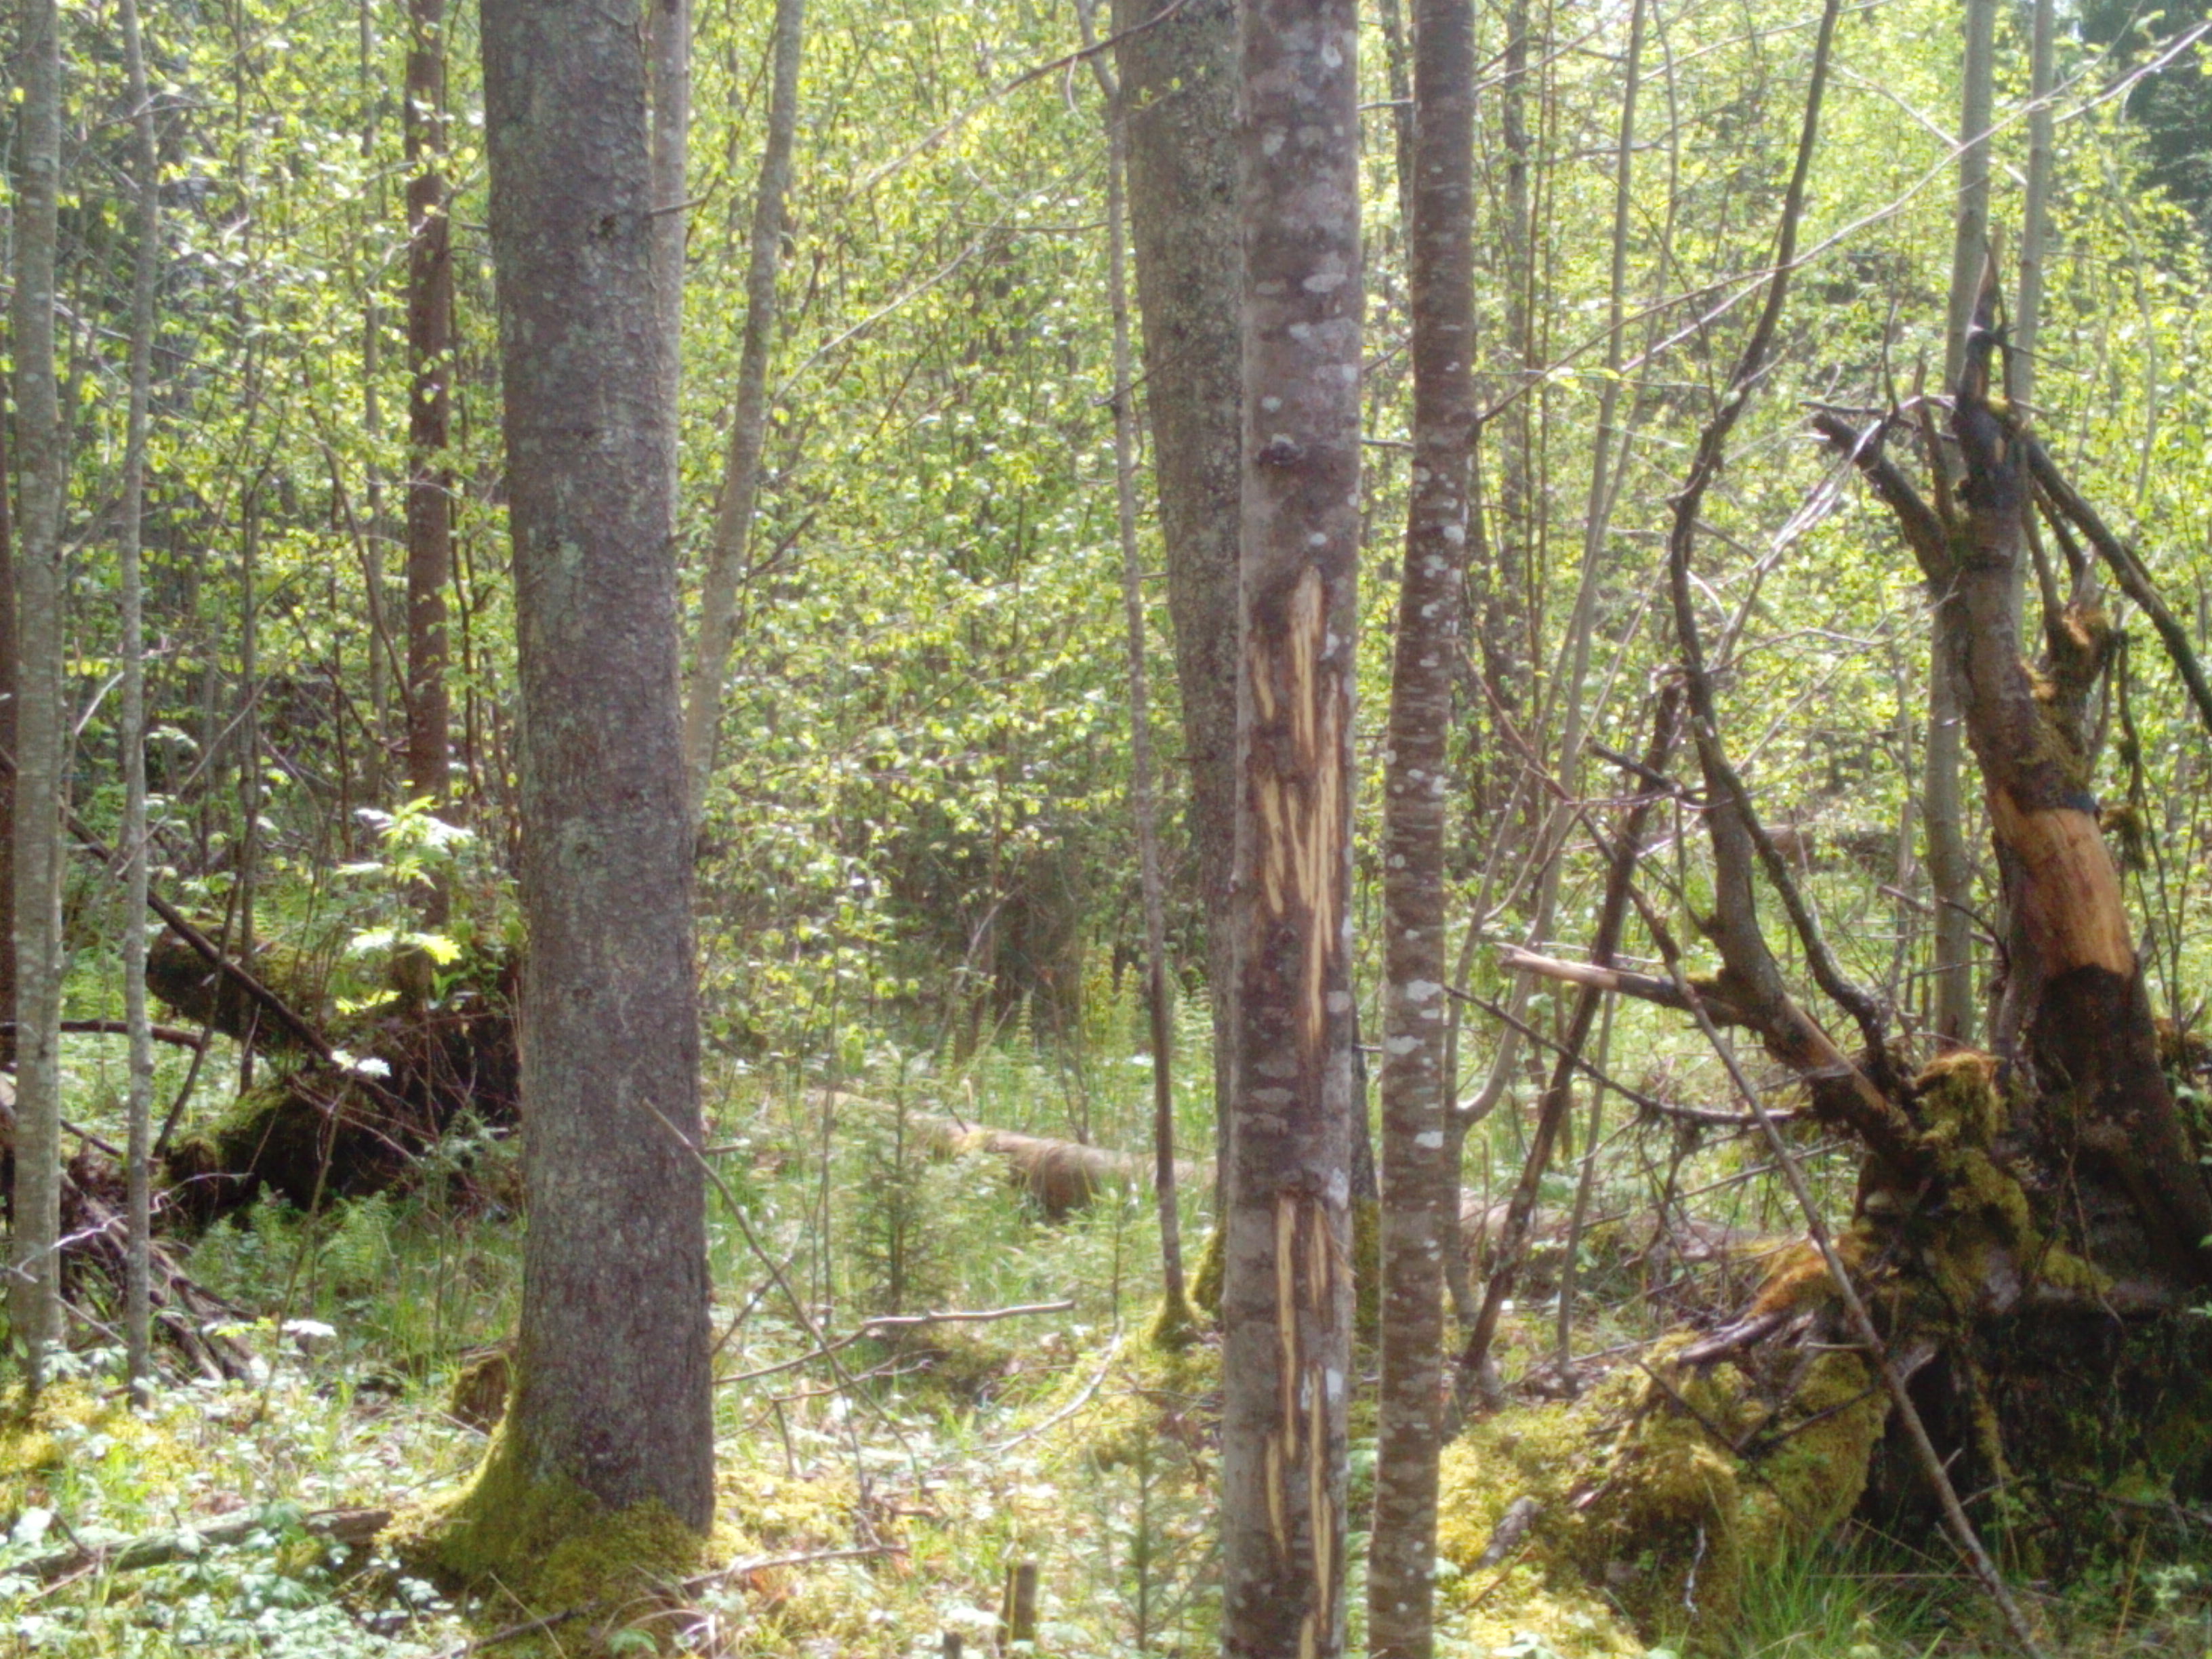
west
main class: Woodland
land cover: Spruce dominated mixed woodland
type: hemiboreal forest and nemoral coniferous forest and mixed broadleaved-coniferous forest
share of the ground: 50 - 75 %
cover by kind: coniferous forest trees 75 %, broadleaved forest trees 25 %
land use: Forestry
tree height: > 5 m
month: May
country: LV
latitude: 56.7084
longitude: 22.8194
